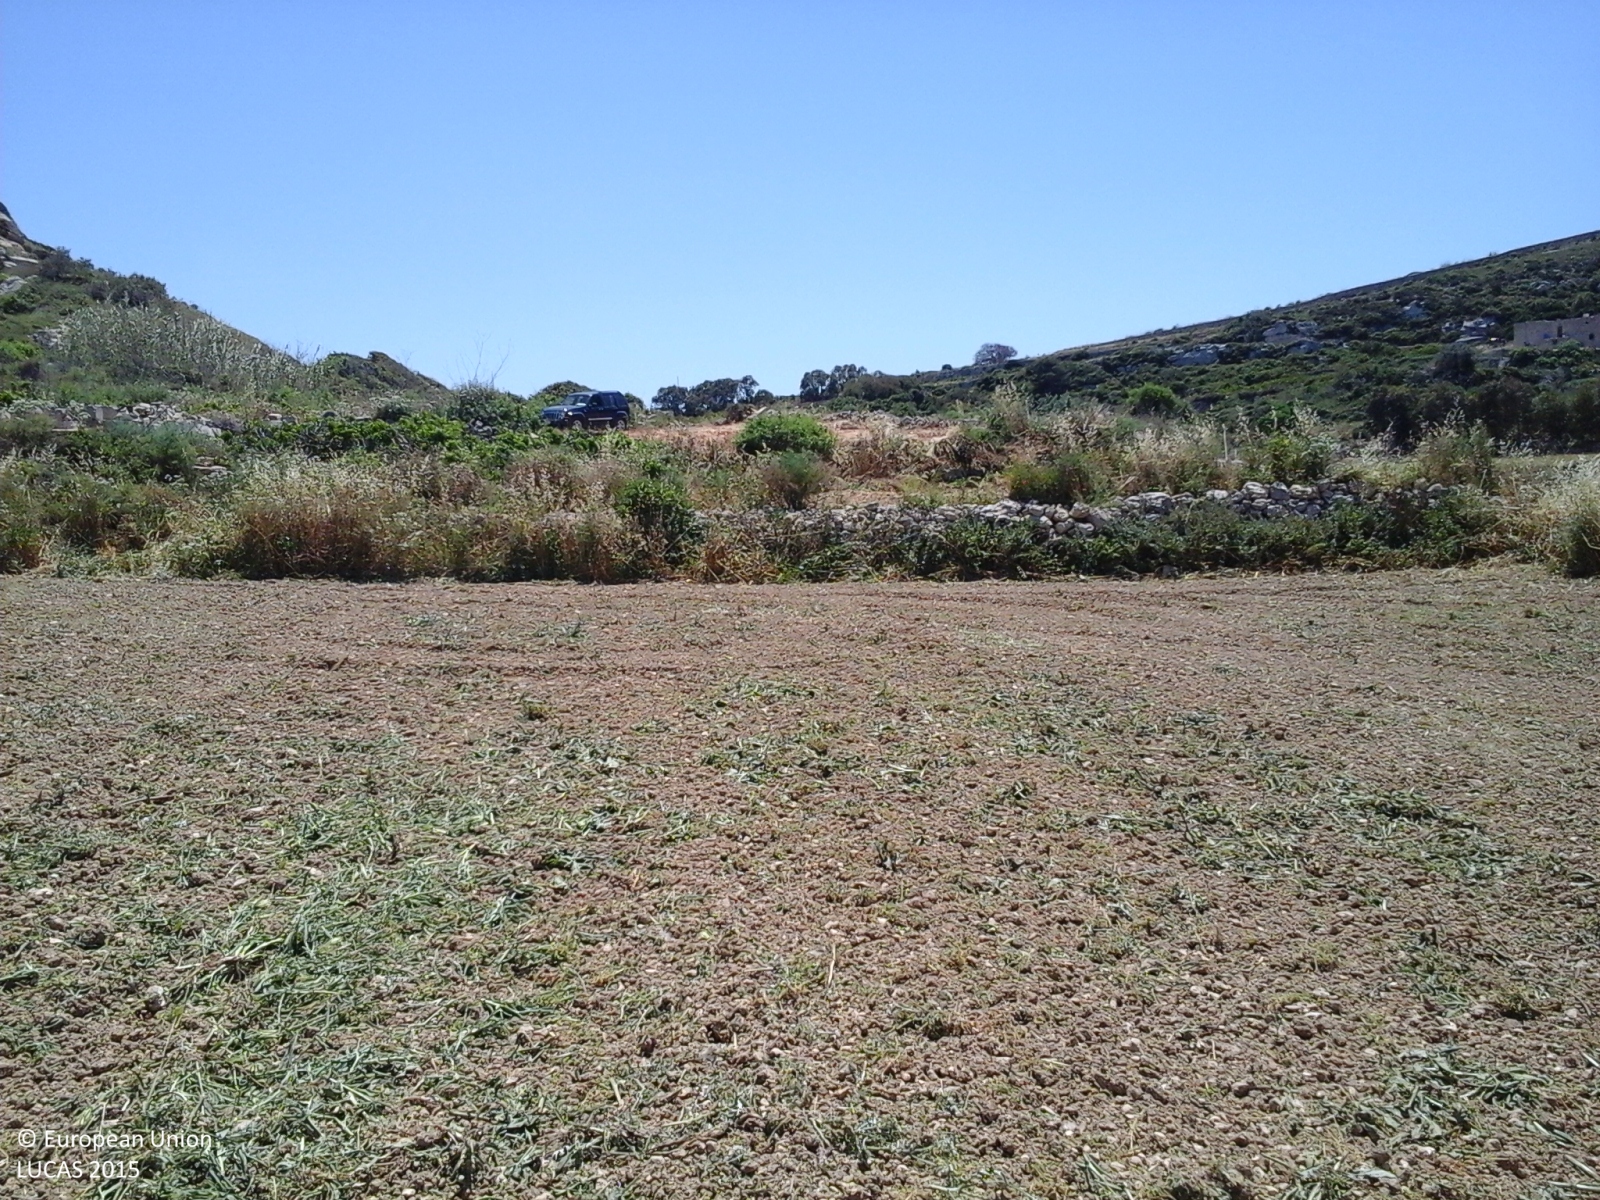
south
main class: Cropland
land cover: Dry pulses
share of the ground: > 75 %
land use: Agriculture (excluding fallow land and kitchen gardens)
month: May
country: MT
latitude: 35.9007
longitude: 14.3582
